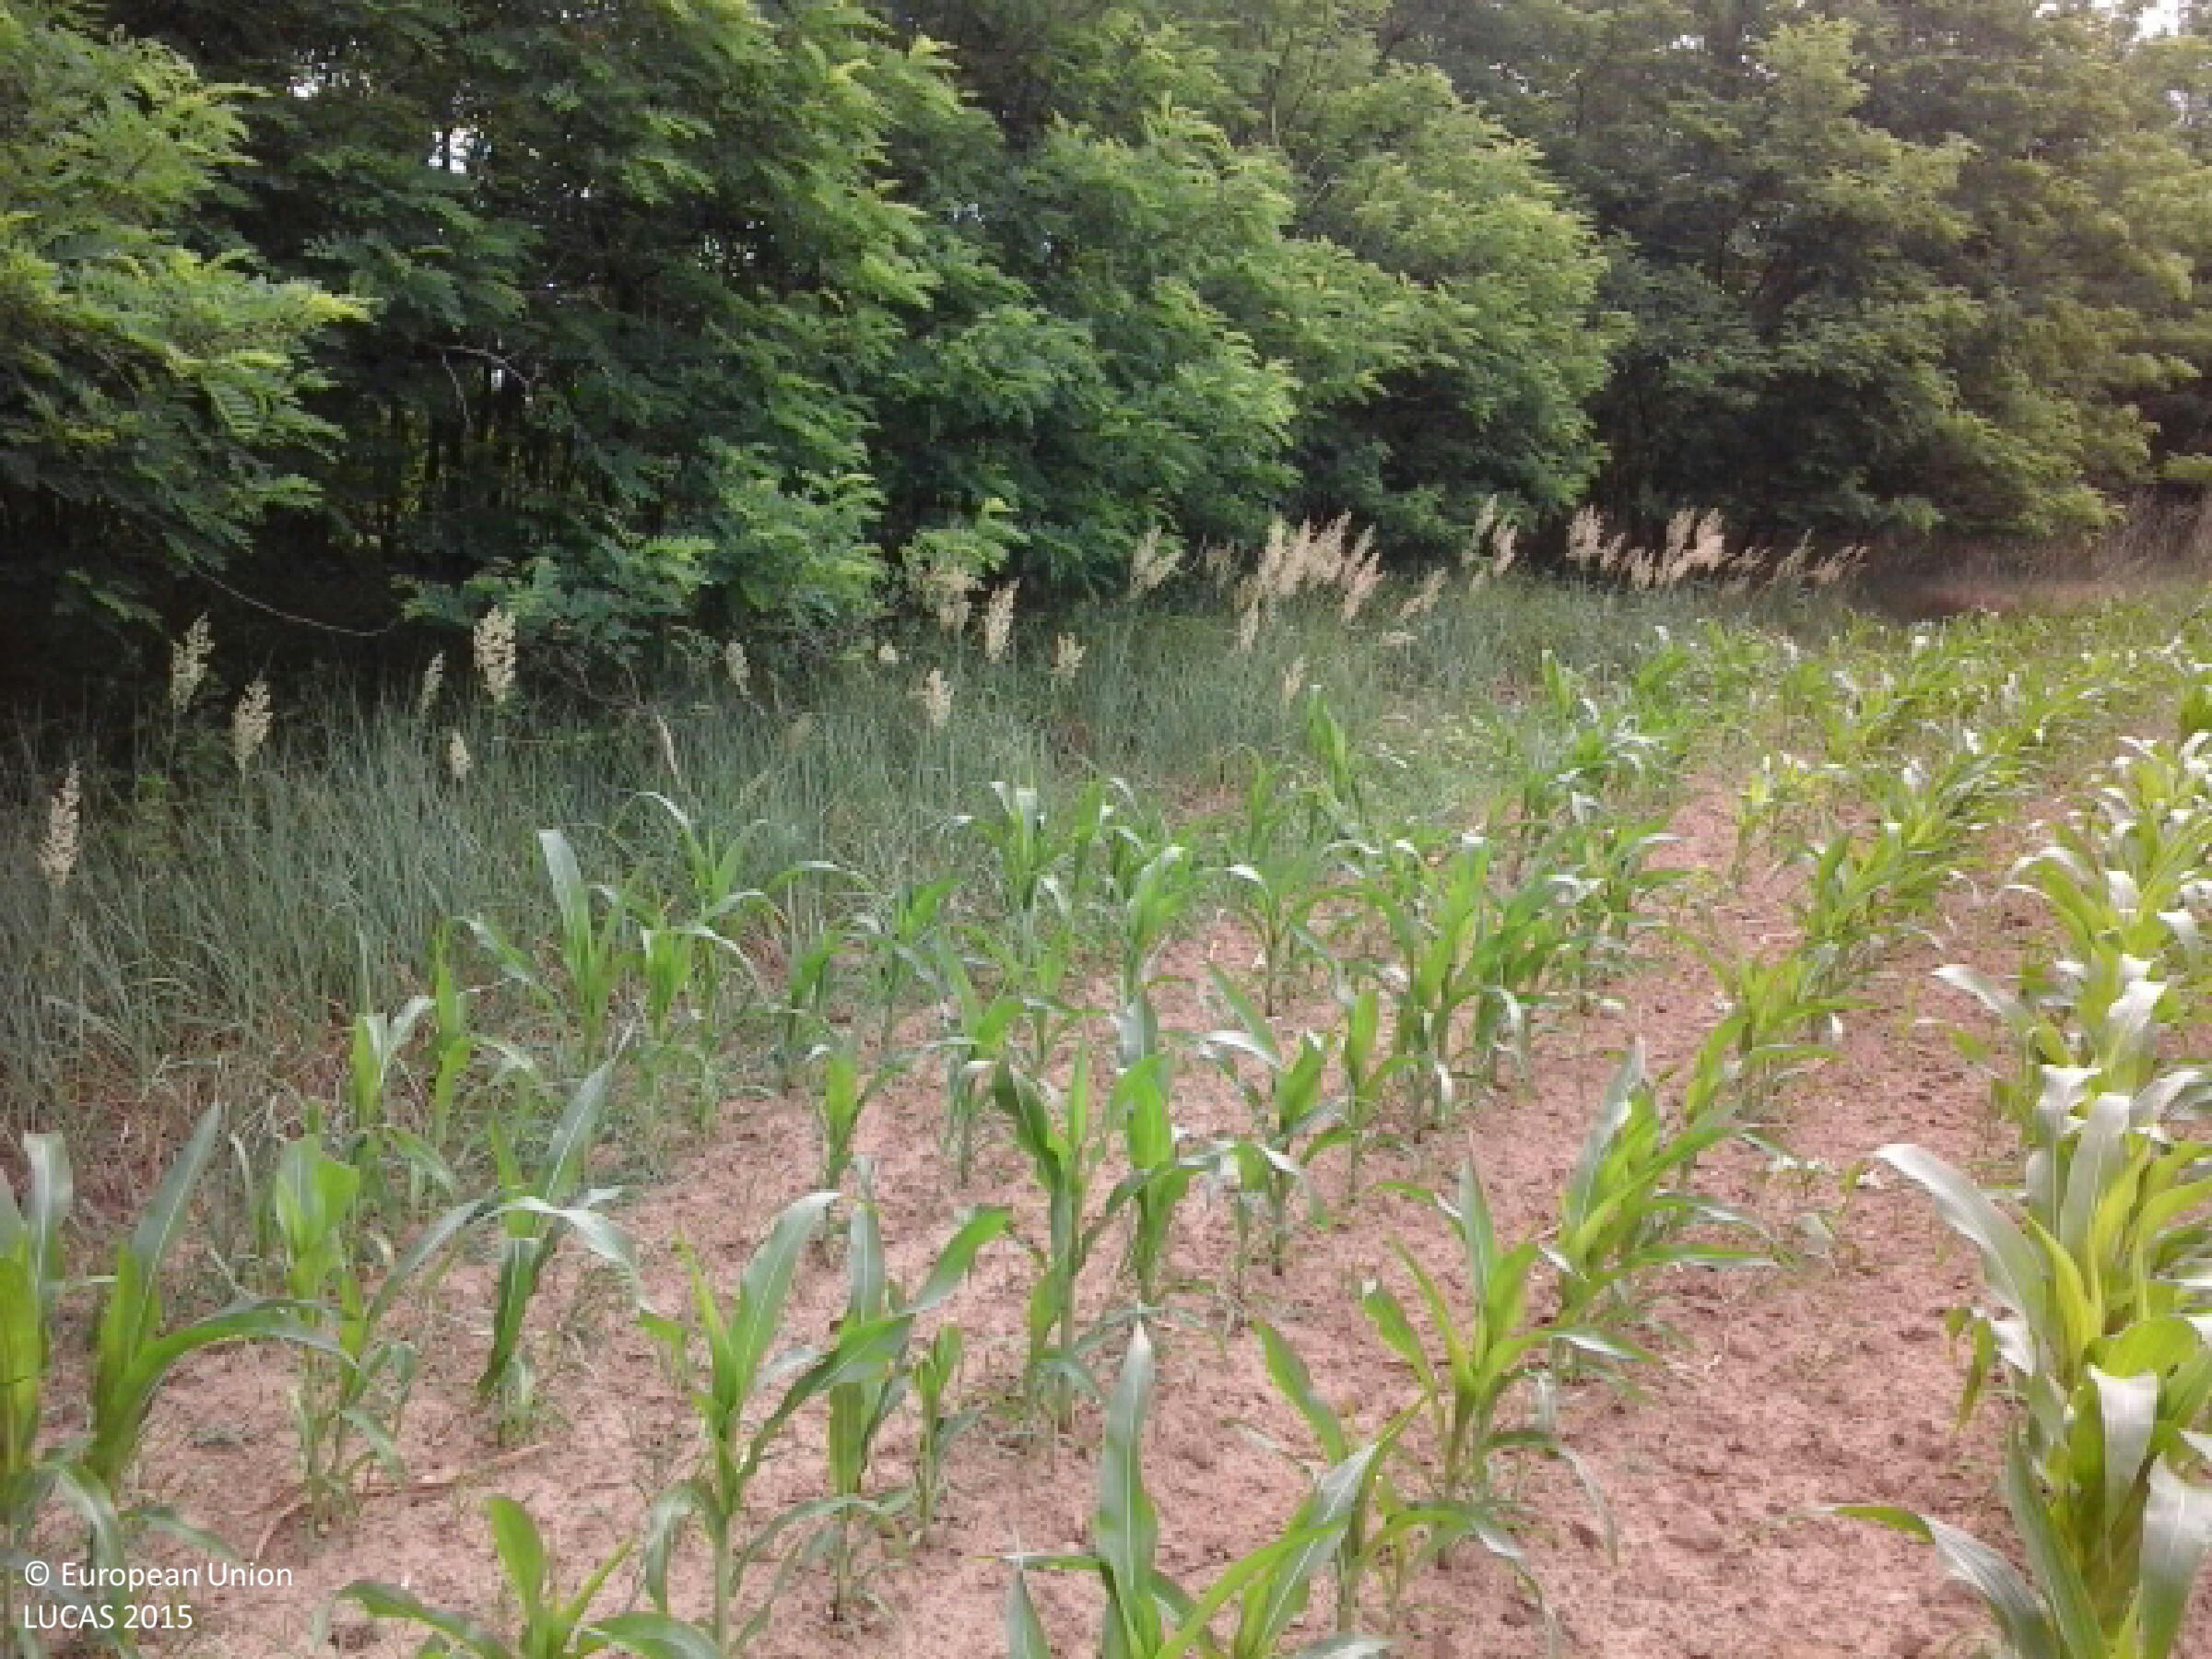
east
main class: Cropland
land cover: Maize
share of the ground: 10 - 25 %
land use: Agriculture (excluding fallow land and kitchen gardens)
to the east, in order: Maize; Broadleaved woodland; Fences; Cherry fruit
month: June
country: HU
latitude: 48.0079
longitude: 21.7780
